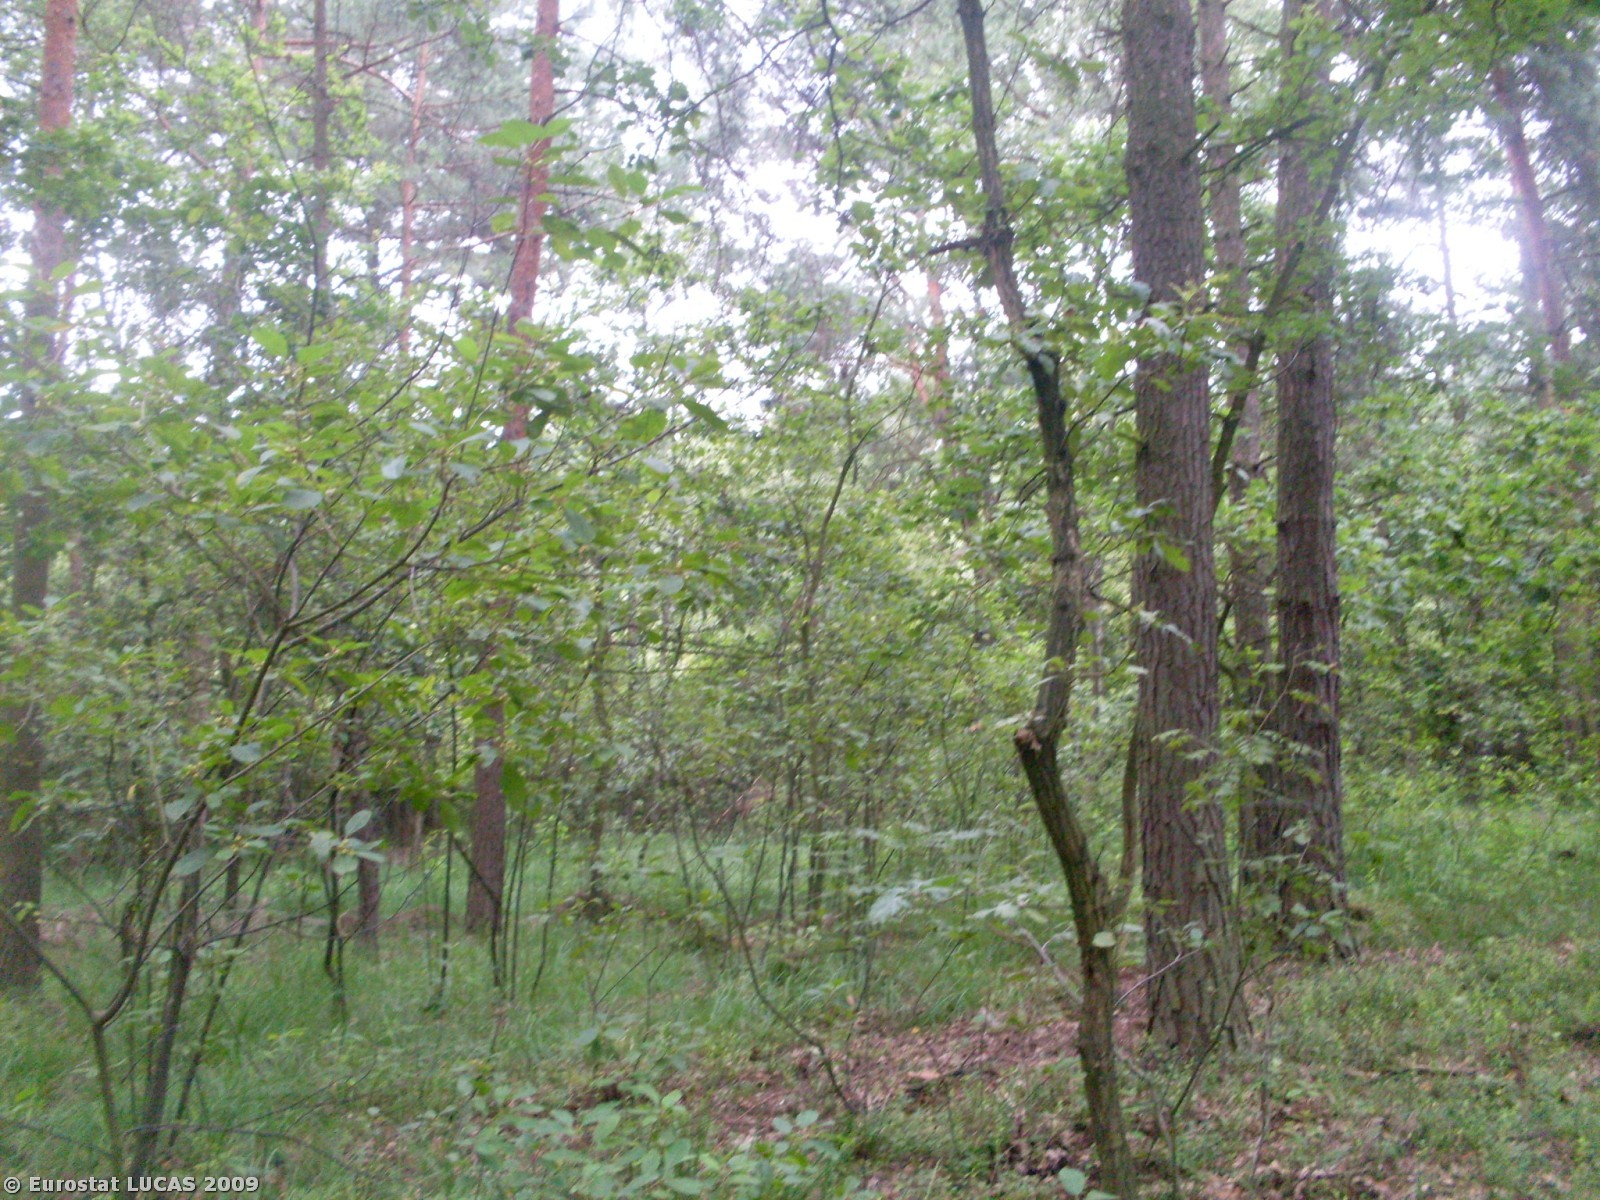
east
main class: Woodland
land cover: Coniferous woodland
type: hemiboreal forest and nemoral coniferous forest and mixed broadleaved-coniferous forest
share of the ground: > 75 %
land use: Forestry
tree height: > 5 m
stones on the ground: < 10 %
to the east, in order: Coniferous woodland; Mixed woodland; Shrubland with sparse tree cover; Mixed woodland
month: August
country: PL
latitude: 50.0733
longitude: 20.5596
